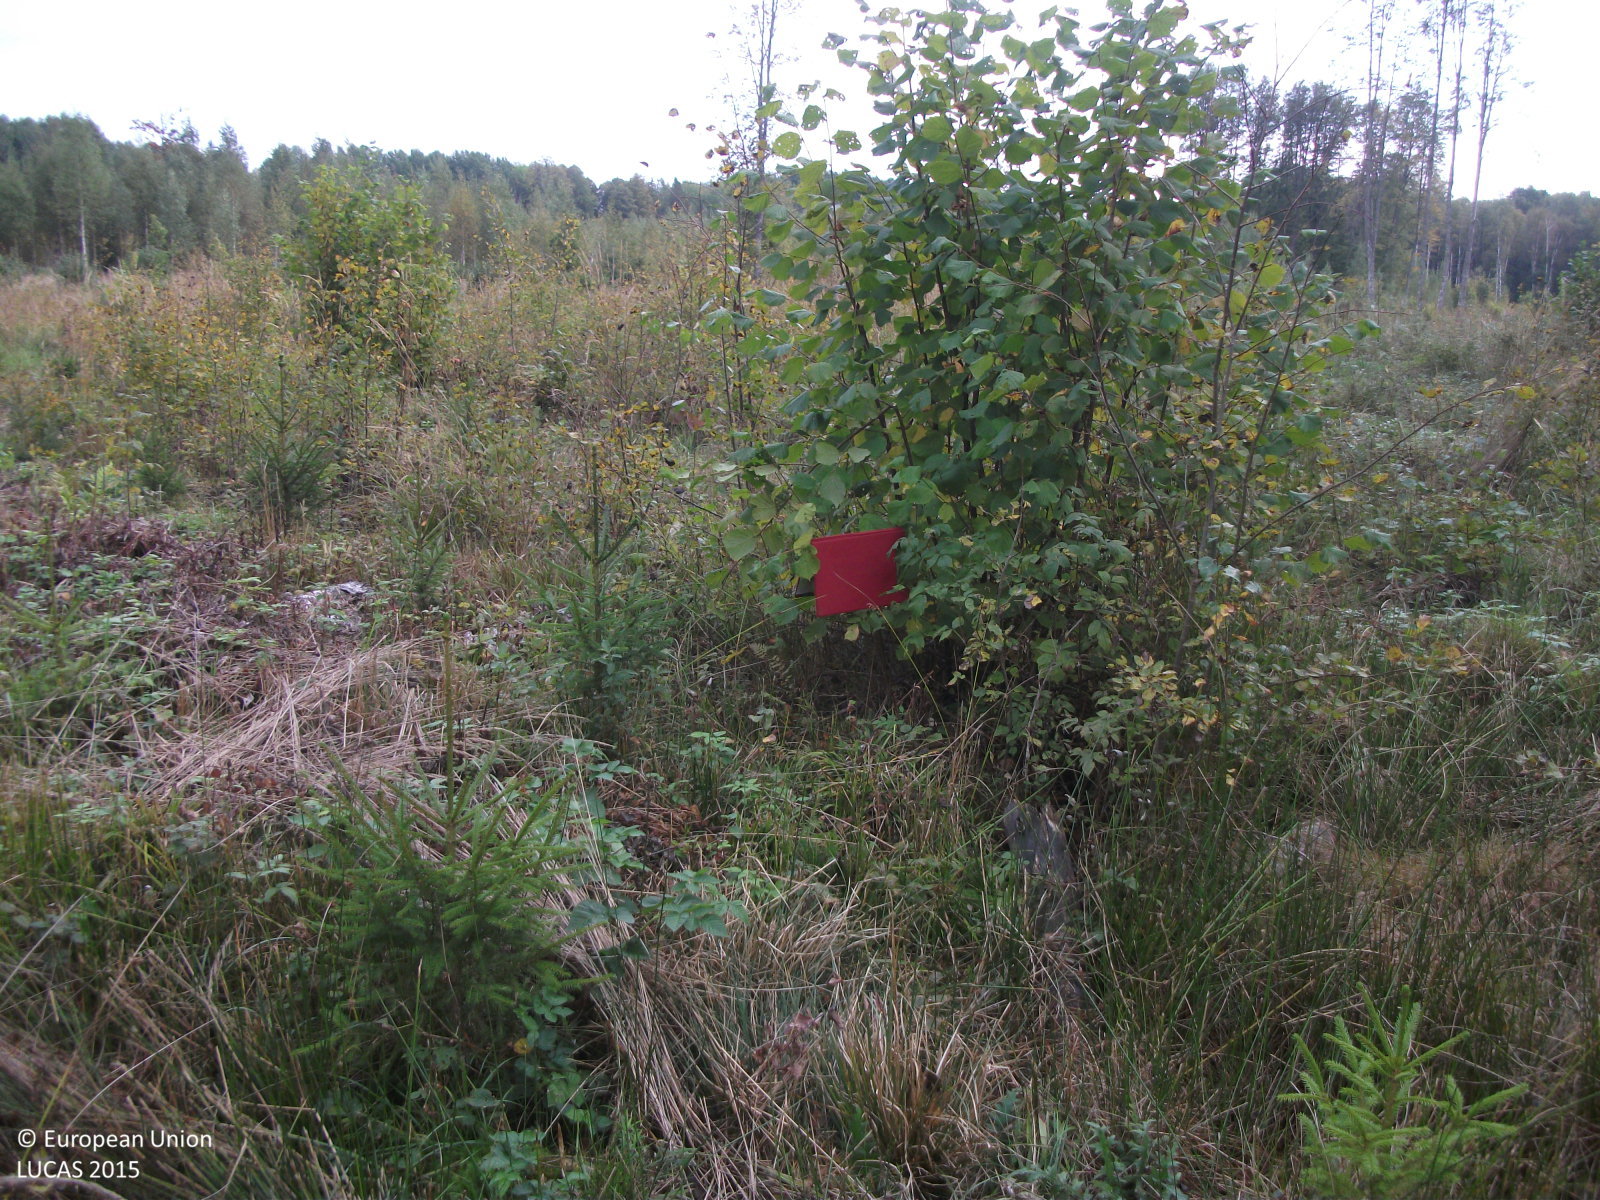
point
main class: Grassland
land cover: Grassland with sparse tree/shrub cover
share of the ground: > 75 %
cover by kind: herbaceous plants 90 %, coniferous forest trees 5 %, shrubs 5 %
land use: Forestry
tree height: < 5 m
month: September
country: LV
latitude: 57.6519
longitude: 24.6211
